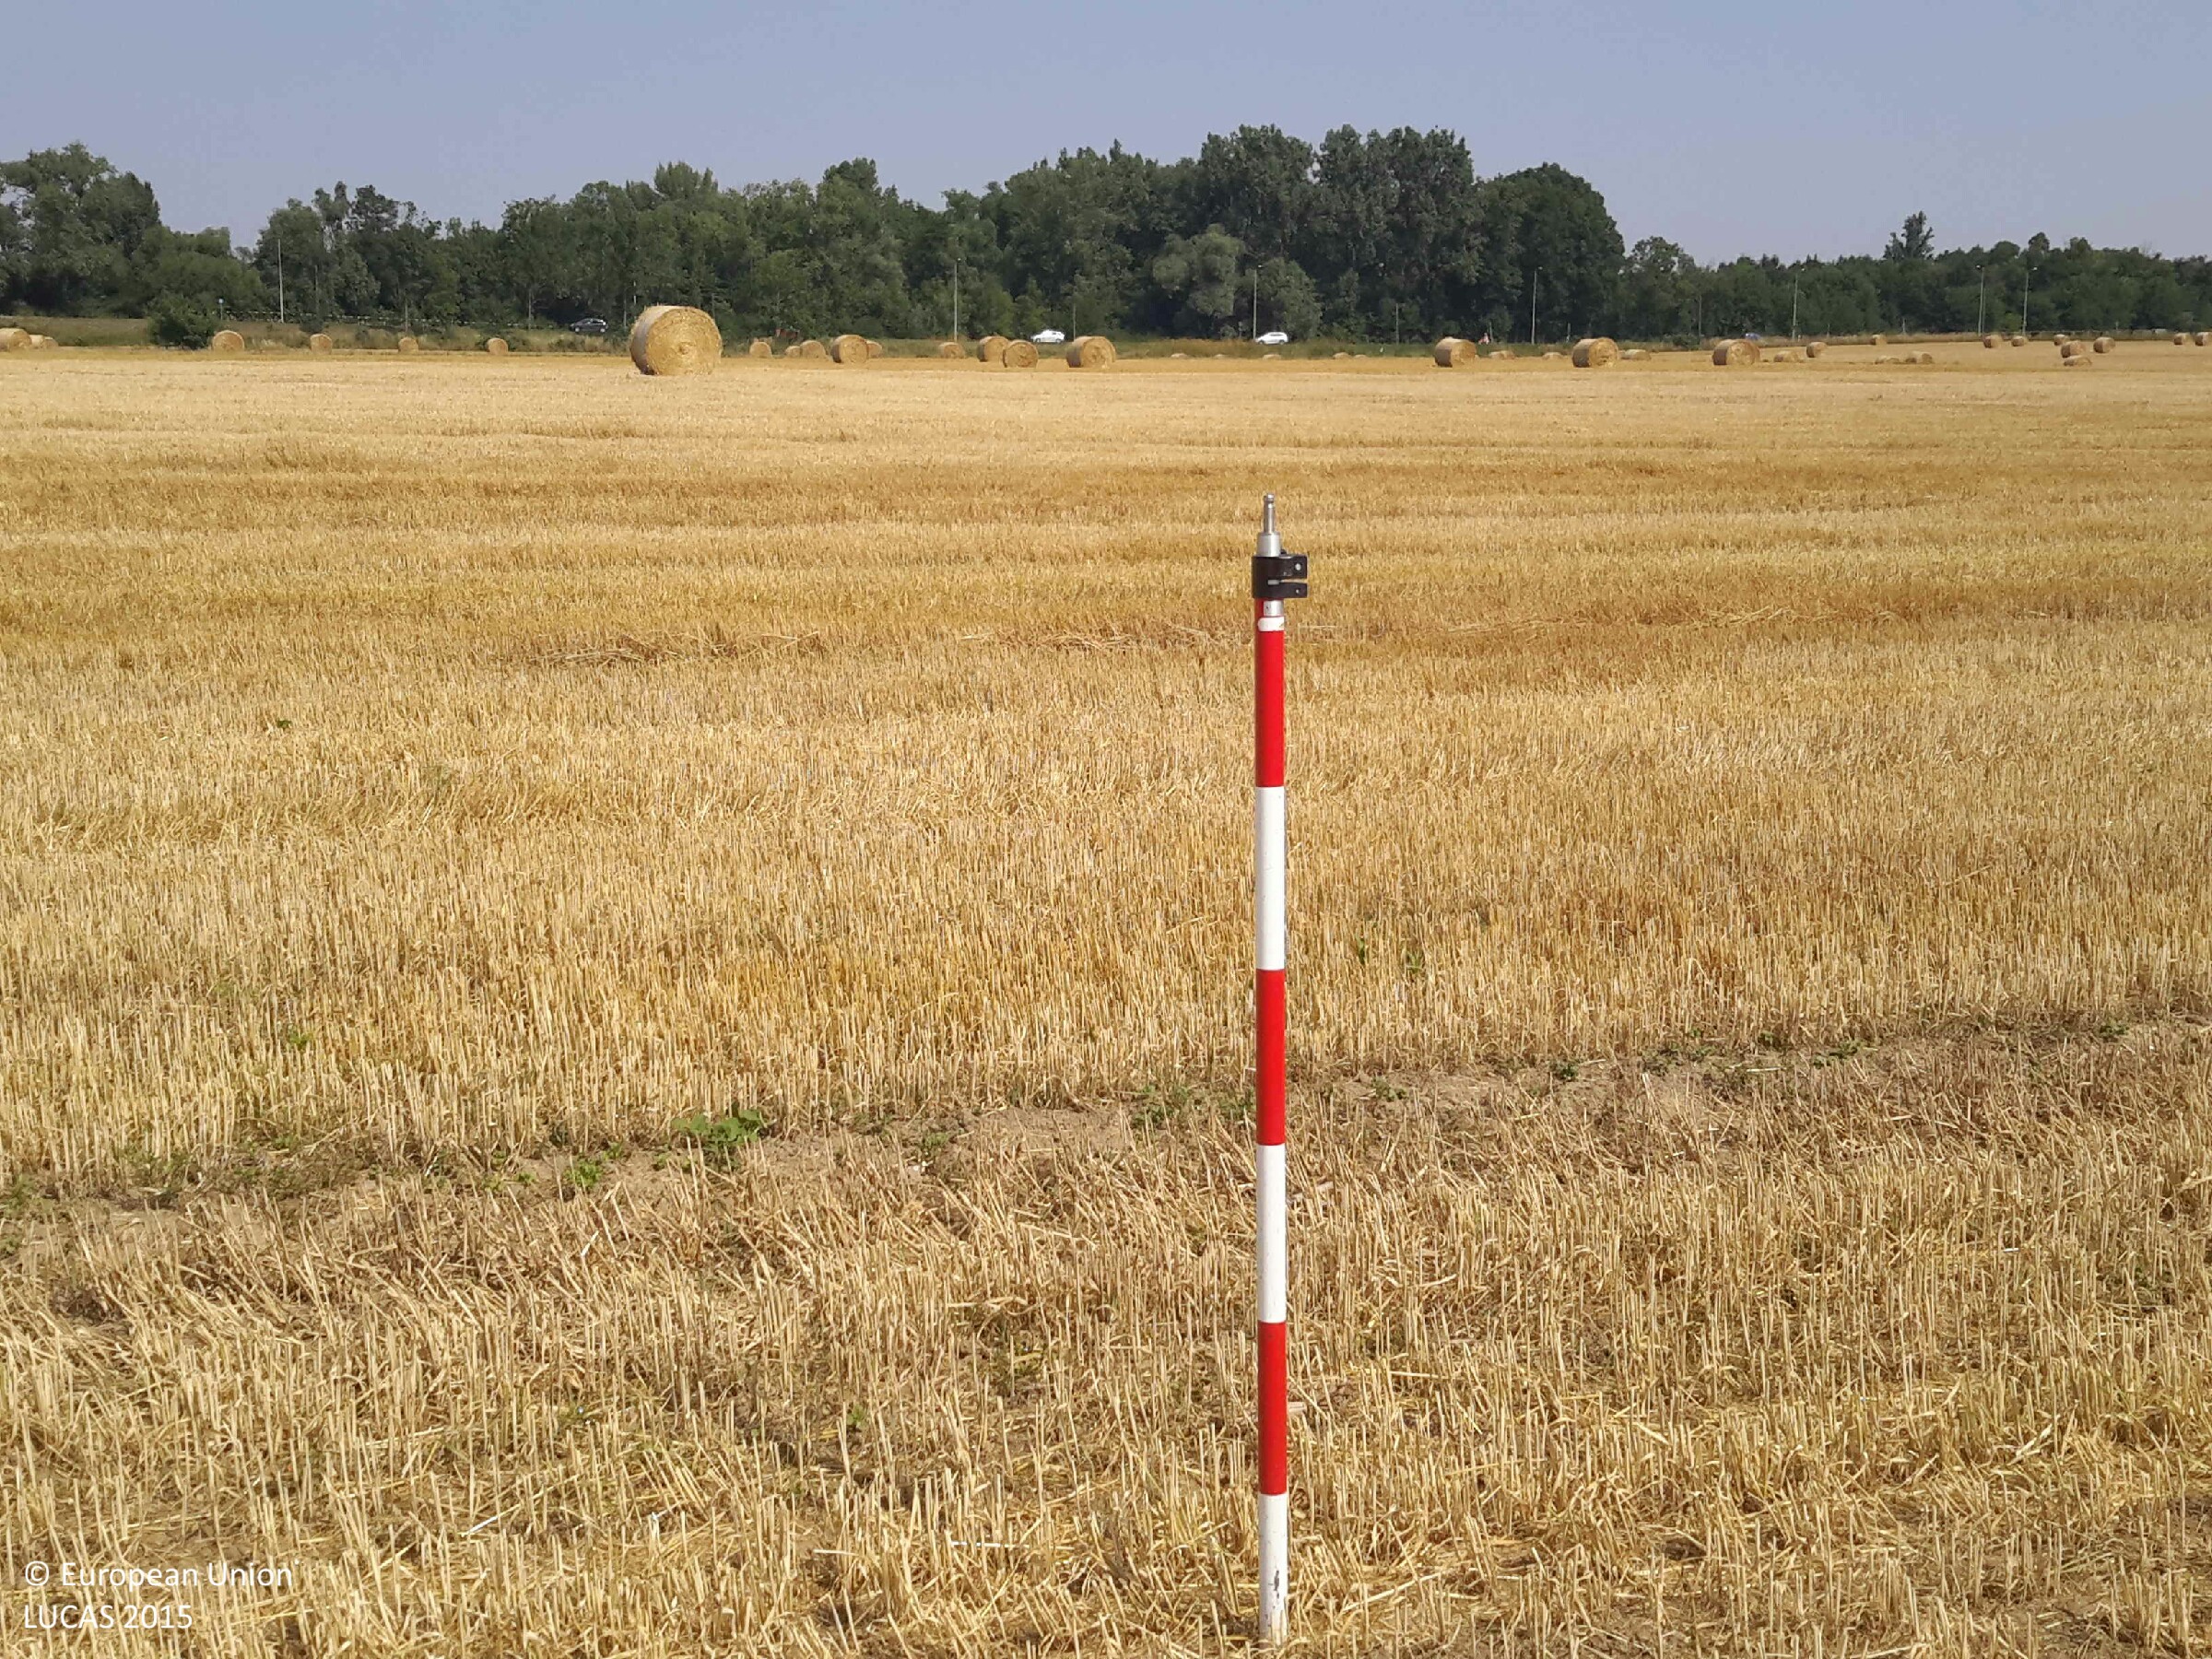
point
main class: Cropland
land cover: Common wheat
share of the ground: 50 - 75 %
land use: Agriculture (excluding fallow land and kitchen gardens)
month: July
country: HU
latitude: 47.4043
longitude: 16.7227
